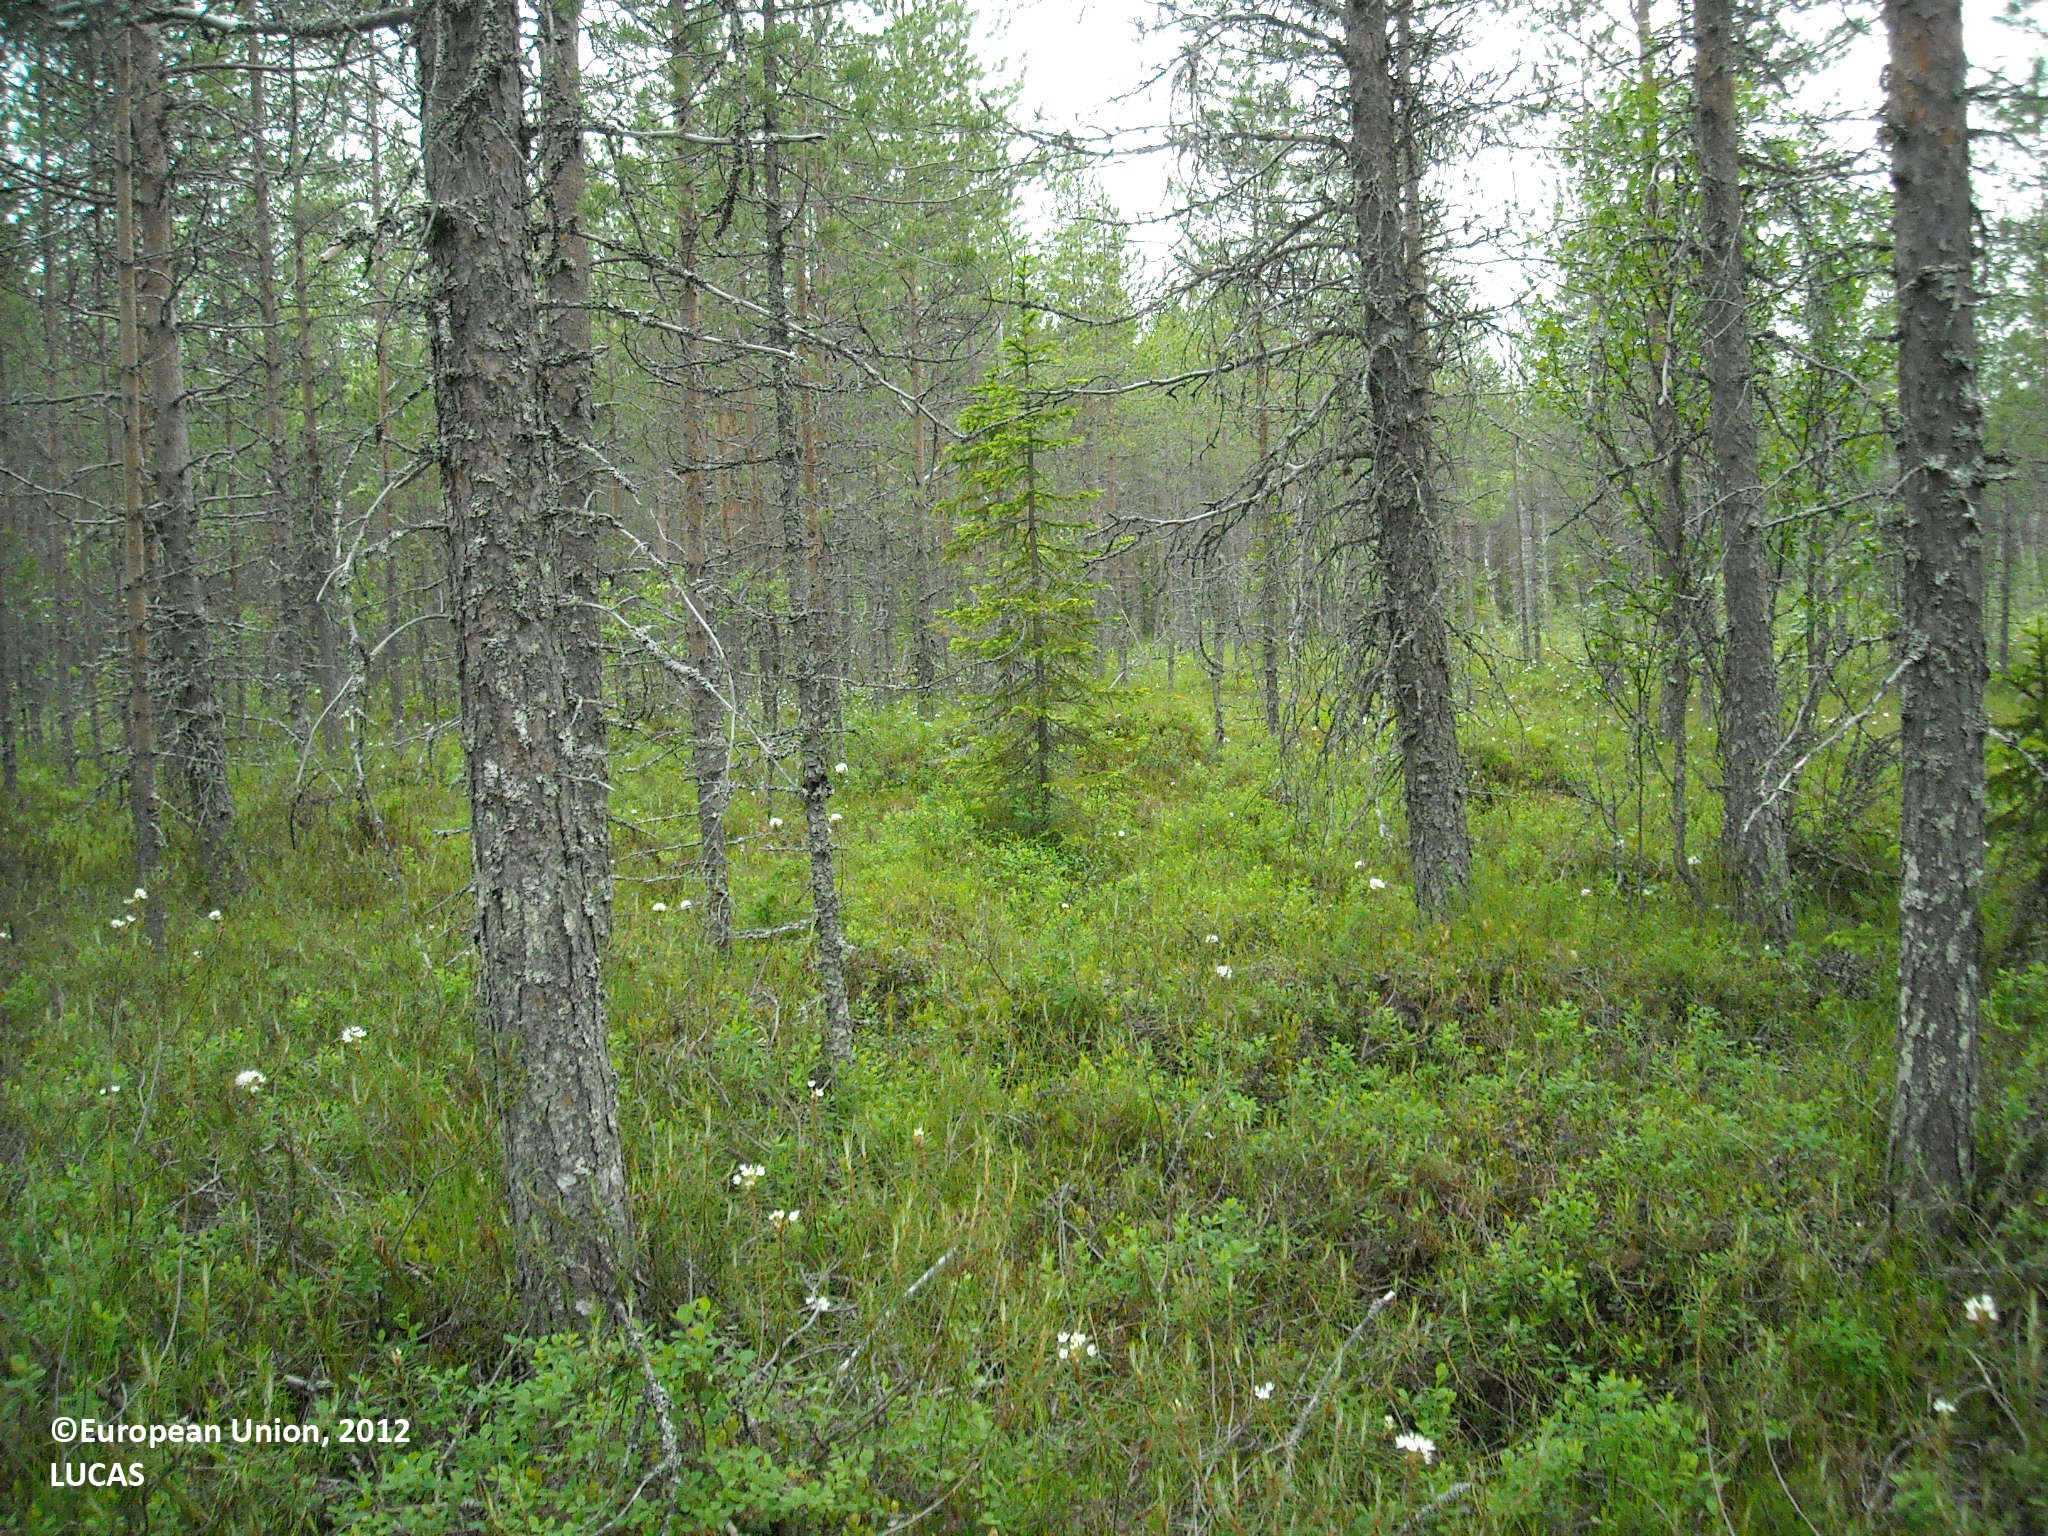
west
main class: Woodland
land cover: Pine dominated coniferous woodland
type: mire and swamp forests
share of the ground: 50 - 75 %
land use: Forestry
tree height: > 5 m
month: June
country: FI
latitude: 64.8474
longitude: 27.4925
